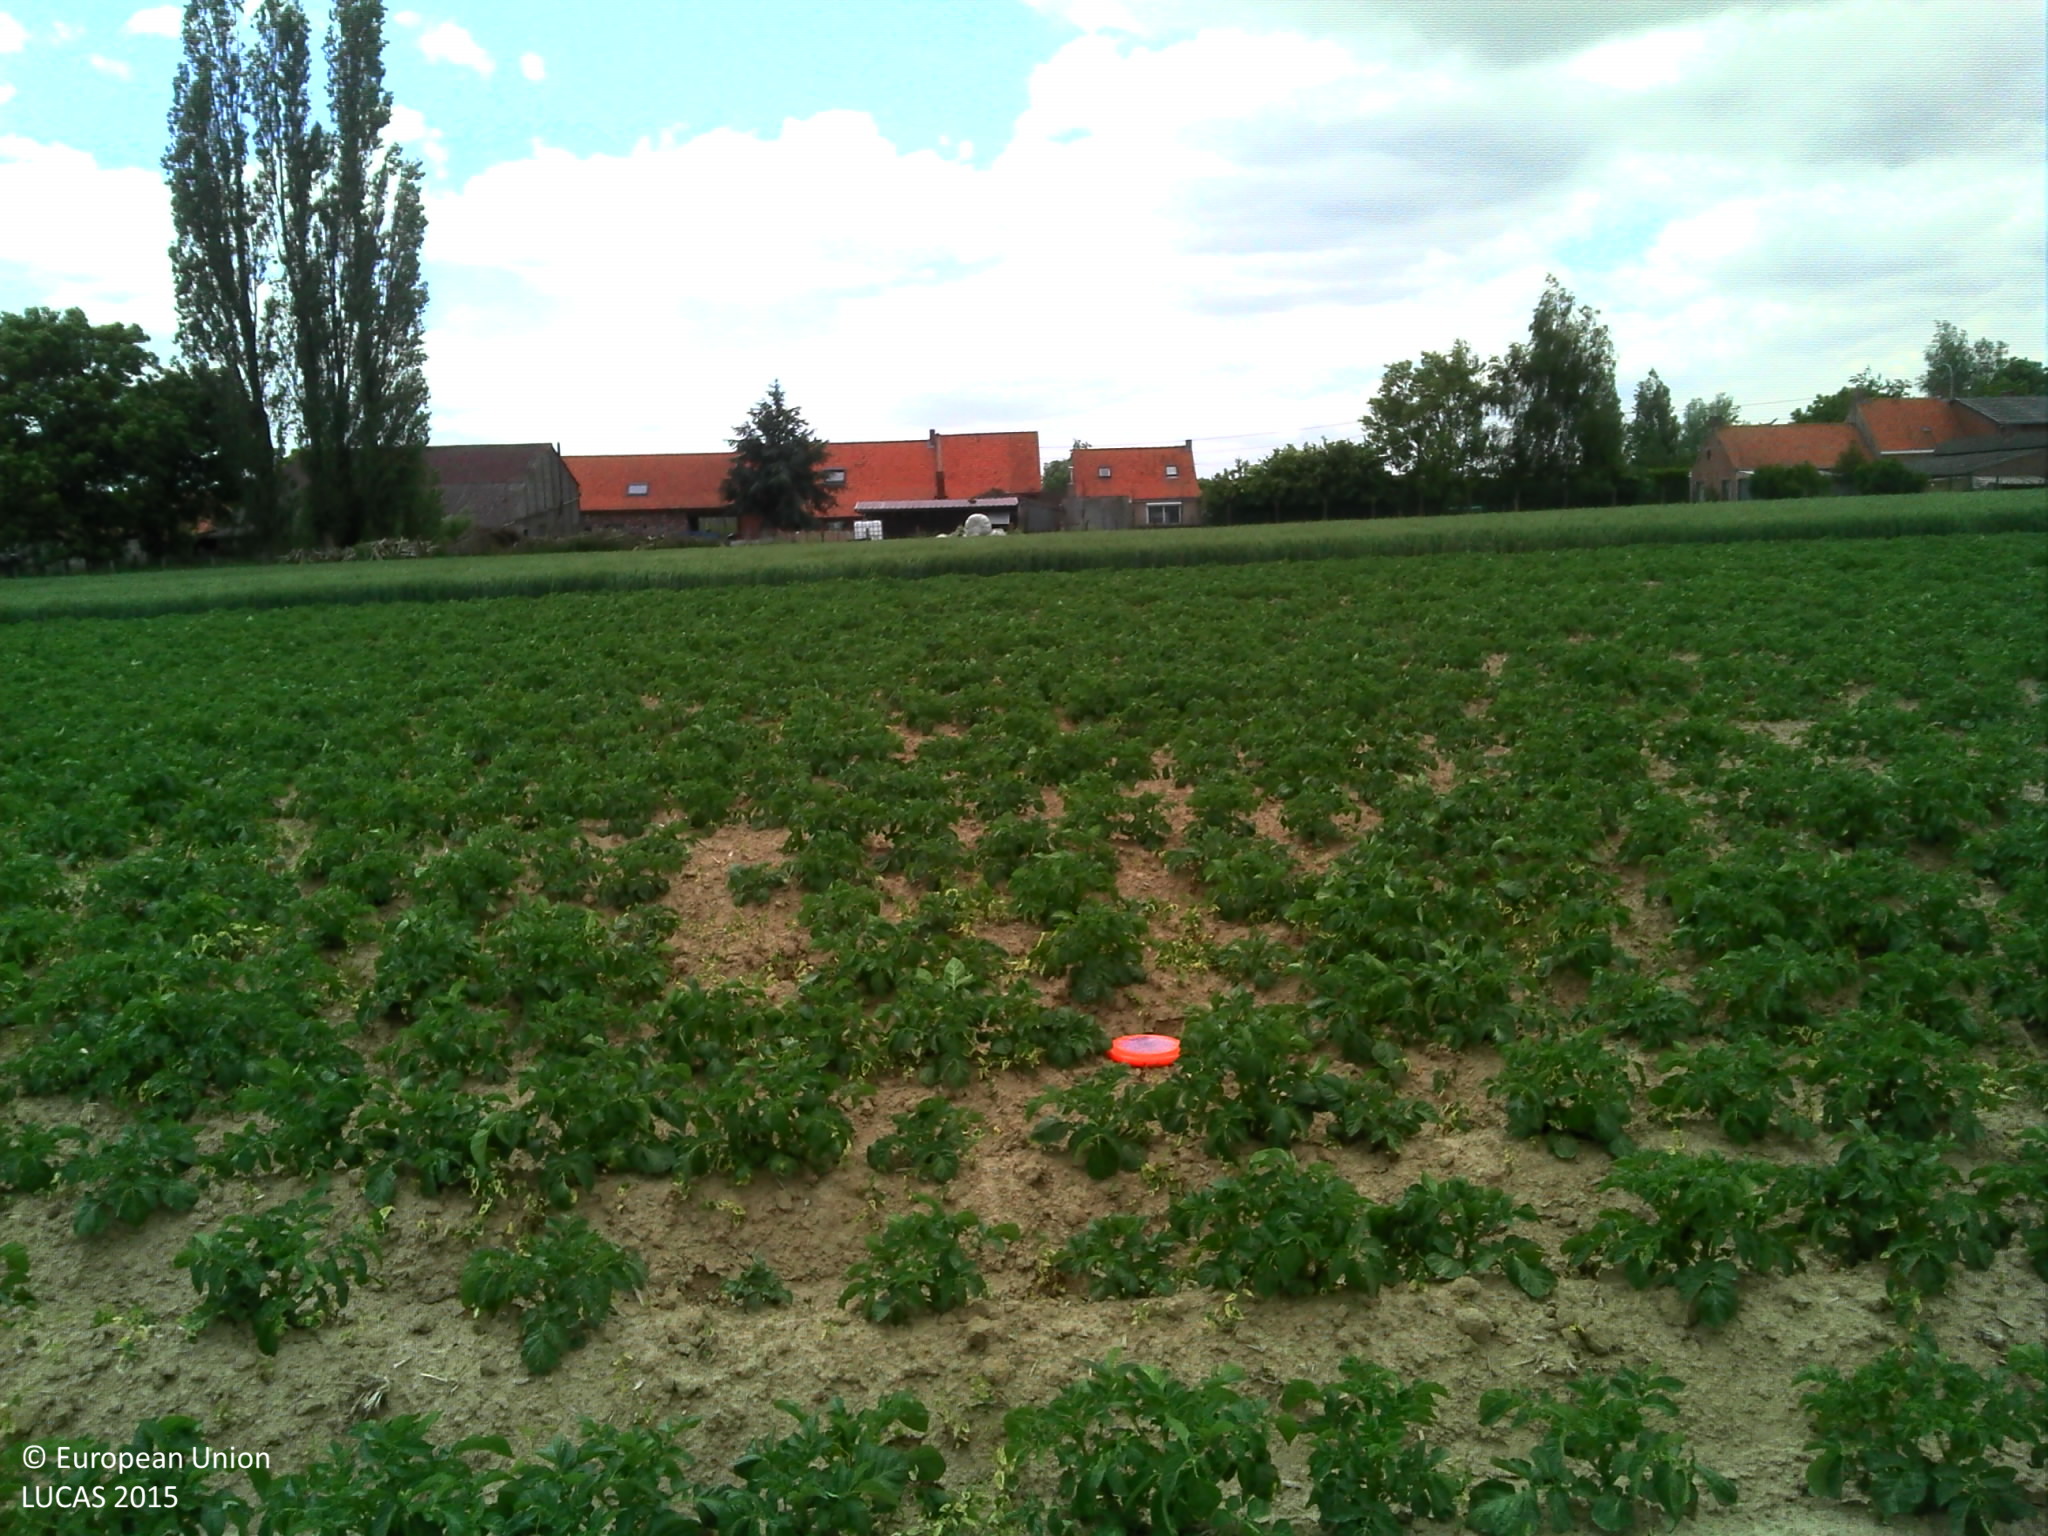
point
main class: Cropland
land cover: Potatoes
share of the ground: 10 - 25 %
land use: Agriculture (excluding fallow land and kitchen gardens)
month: June
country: BE
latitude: 50.8386
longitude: 2.7607
